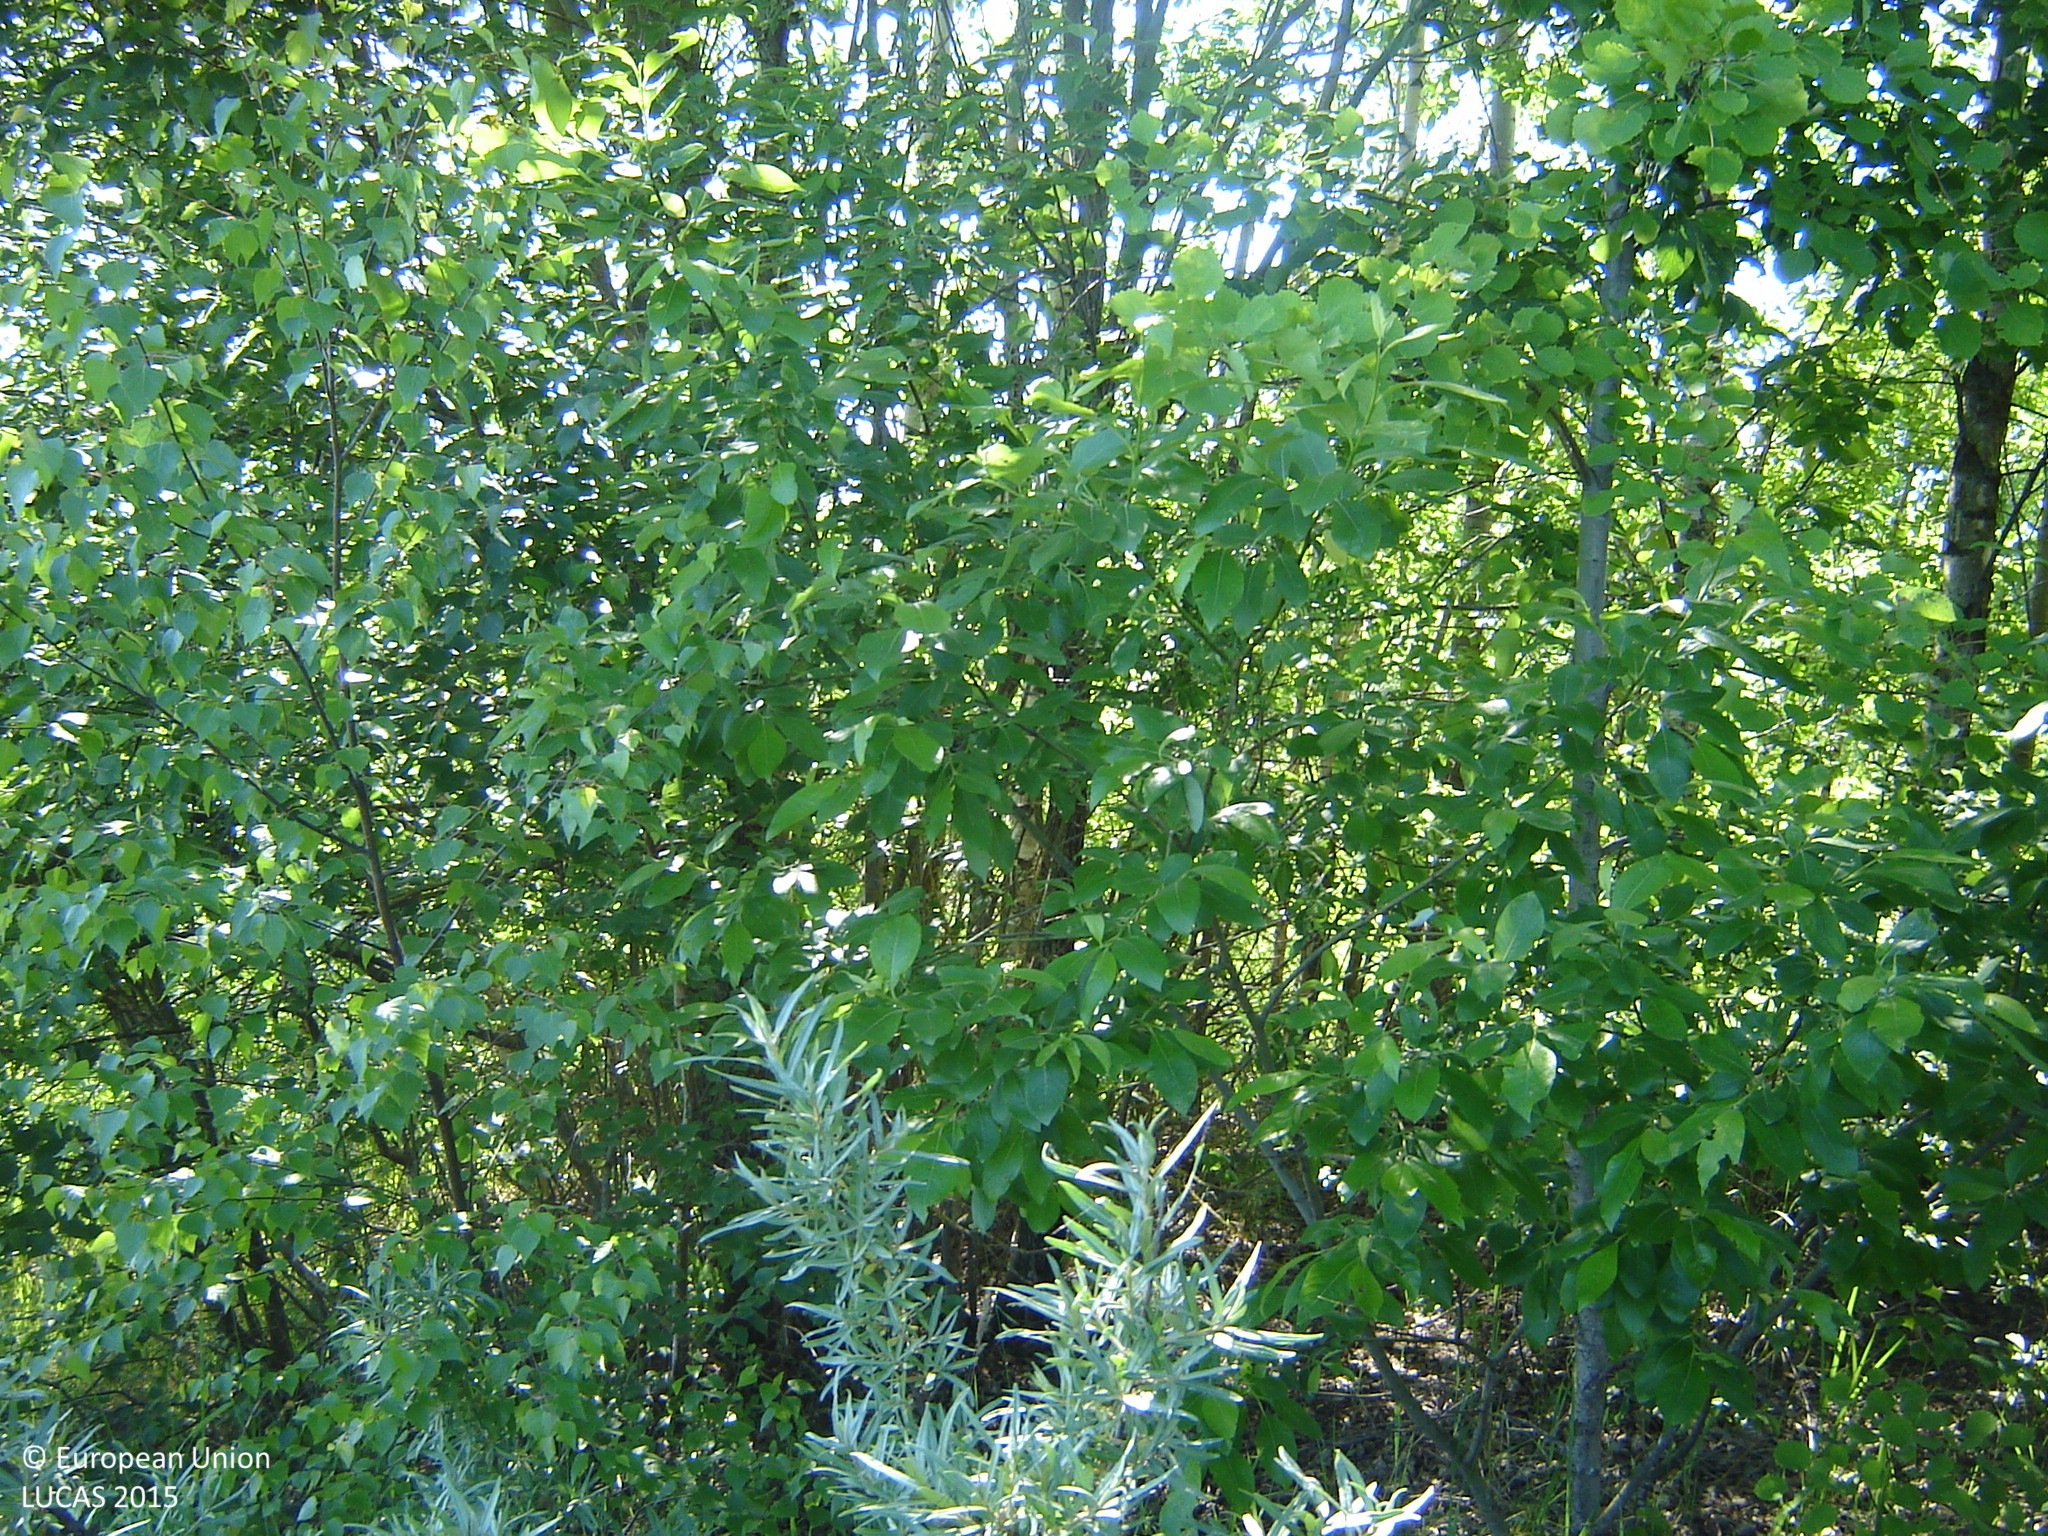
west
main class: Woodland
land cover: Broadleaved woodland
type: non-riverine alder, birch or aspen forest
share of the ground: > 75 %
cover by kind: broadleaved forest trees 75 %, herbaceous plants 20 %, shrubs 5 %
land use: Semi-natural and natural areas not in use
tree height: > 5 m
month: June
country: LT
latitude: 55.5269
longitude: 25.0840
